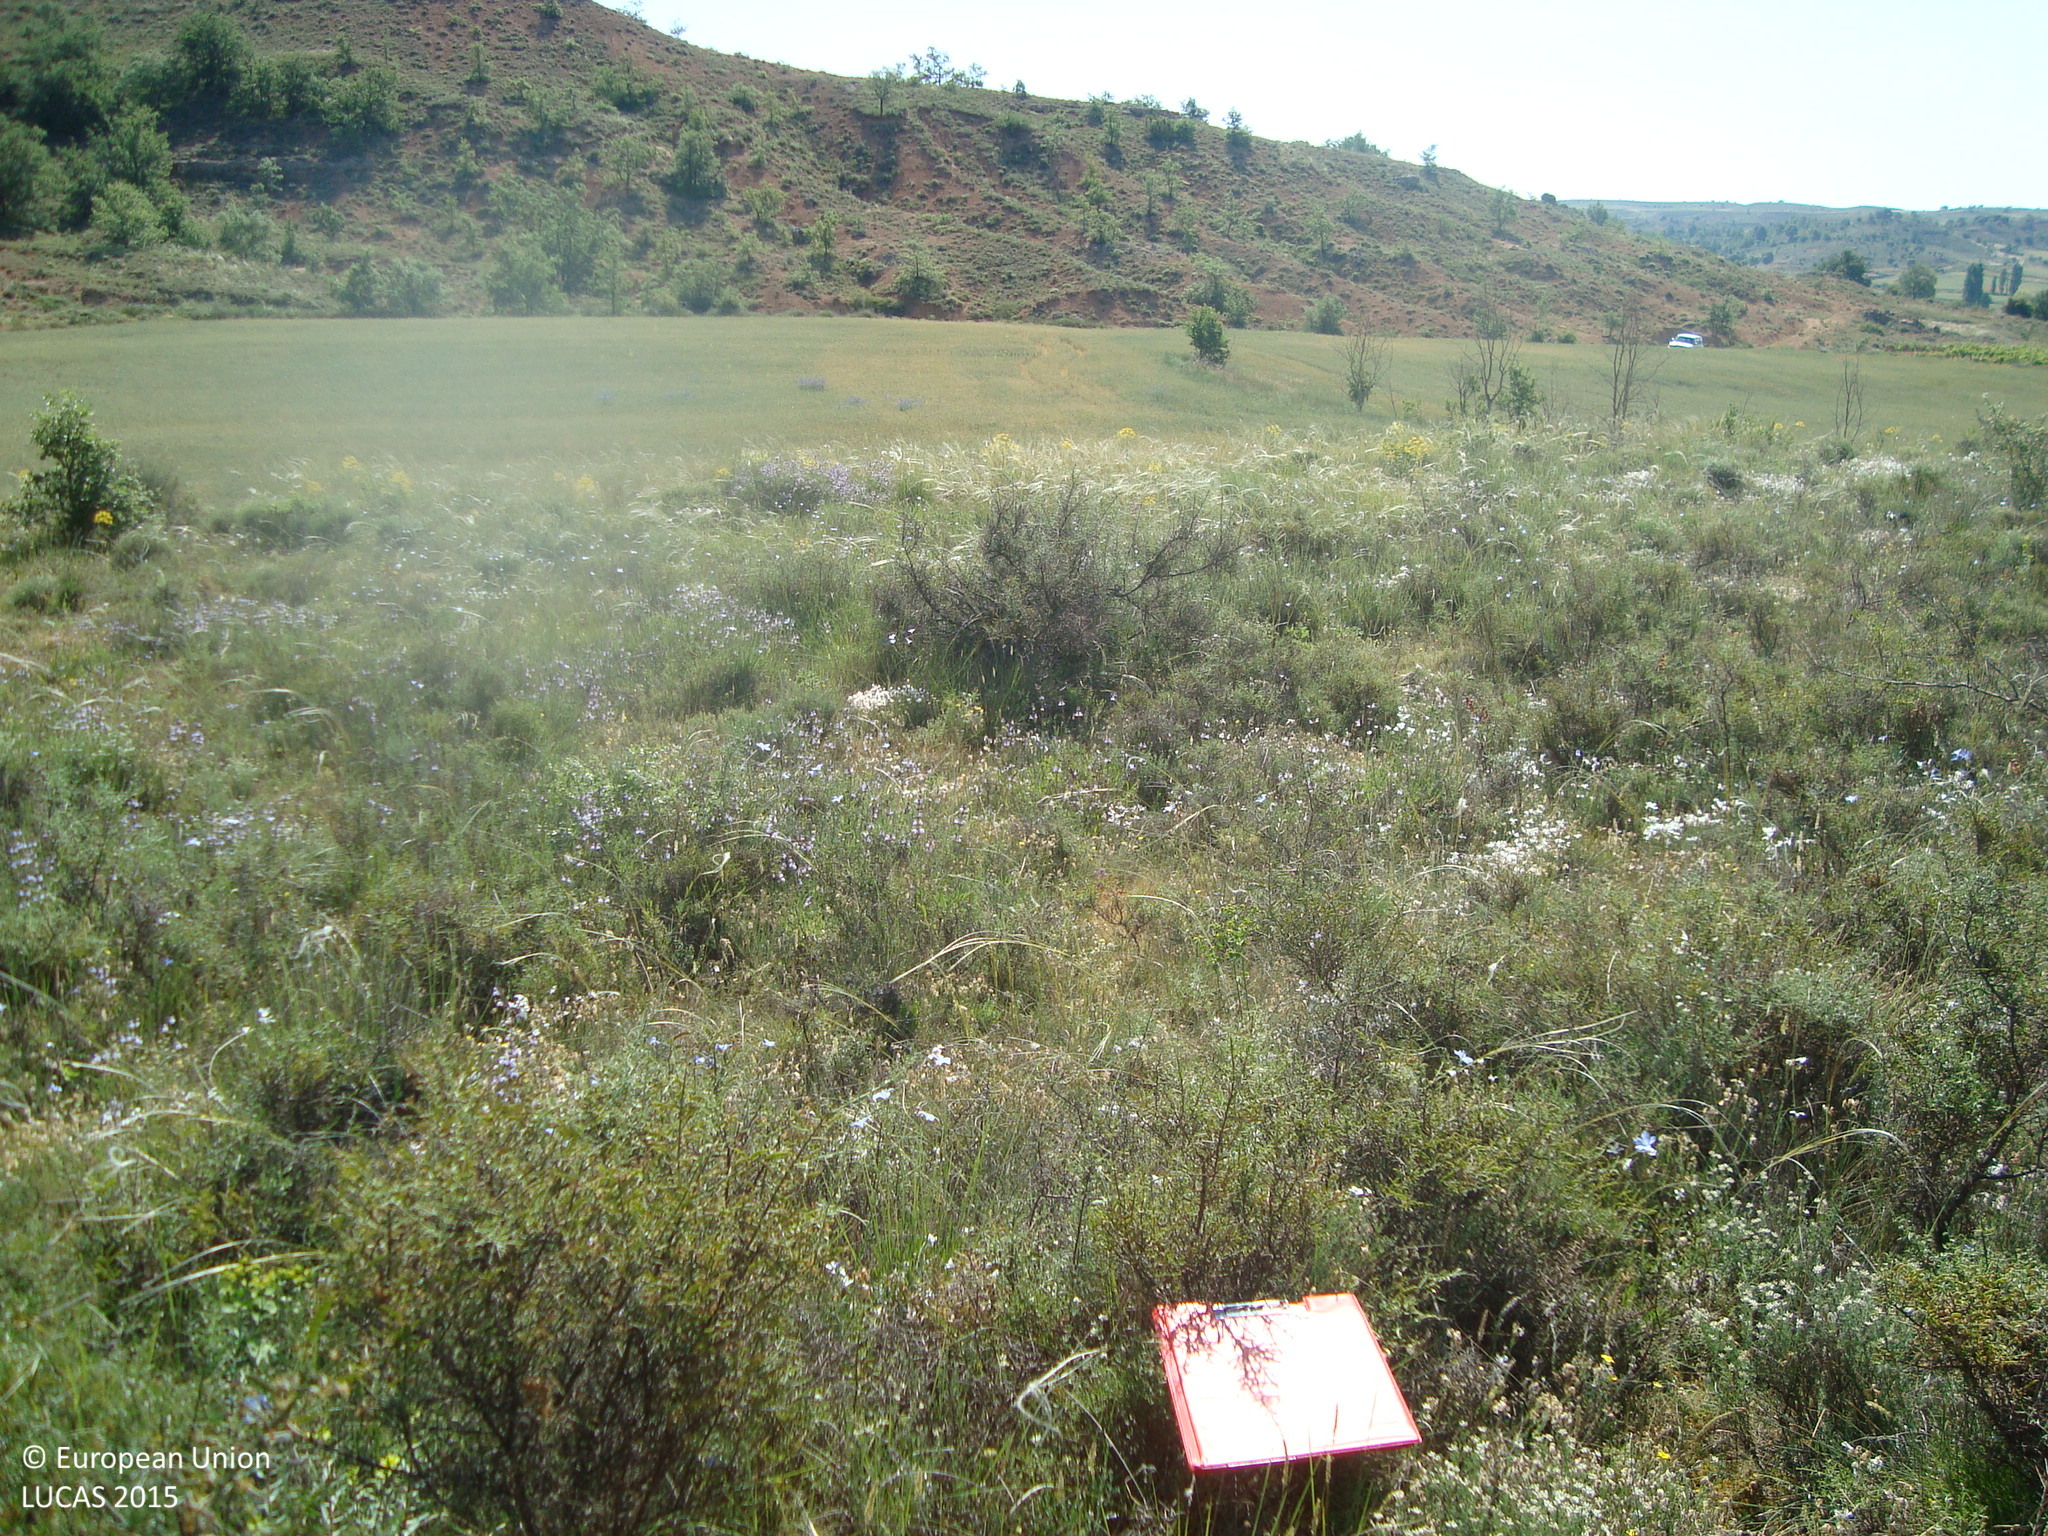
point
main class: Shrubland
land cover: Shrubland with sparse tree cover
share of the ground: > 75 %
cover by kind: shrubs 75 %, herbaceous plants 15 %, broadleaved forest trees 5 %, unconsolidated bare surface 5 %
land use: Semi-natural and natural areas not in use
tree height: < 5 m
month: June
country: ES
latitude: 41.7784
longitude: -3.6608
